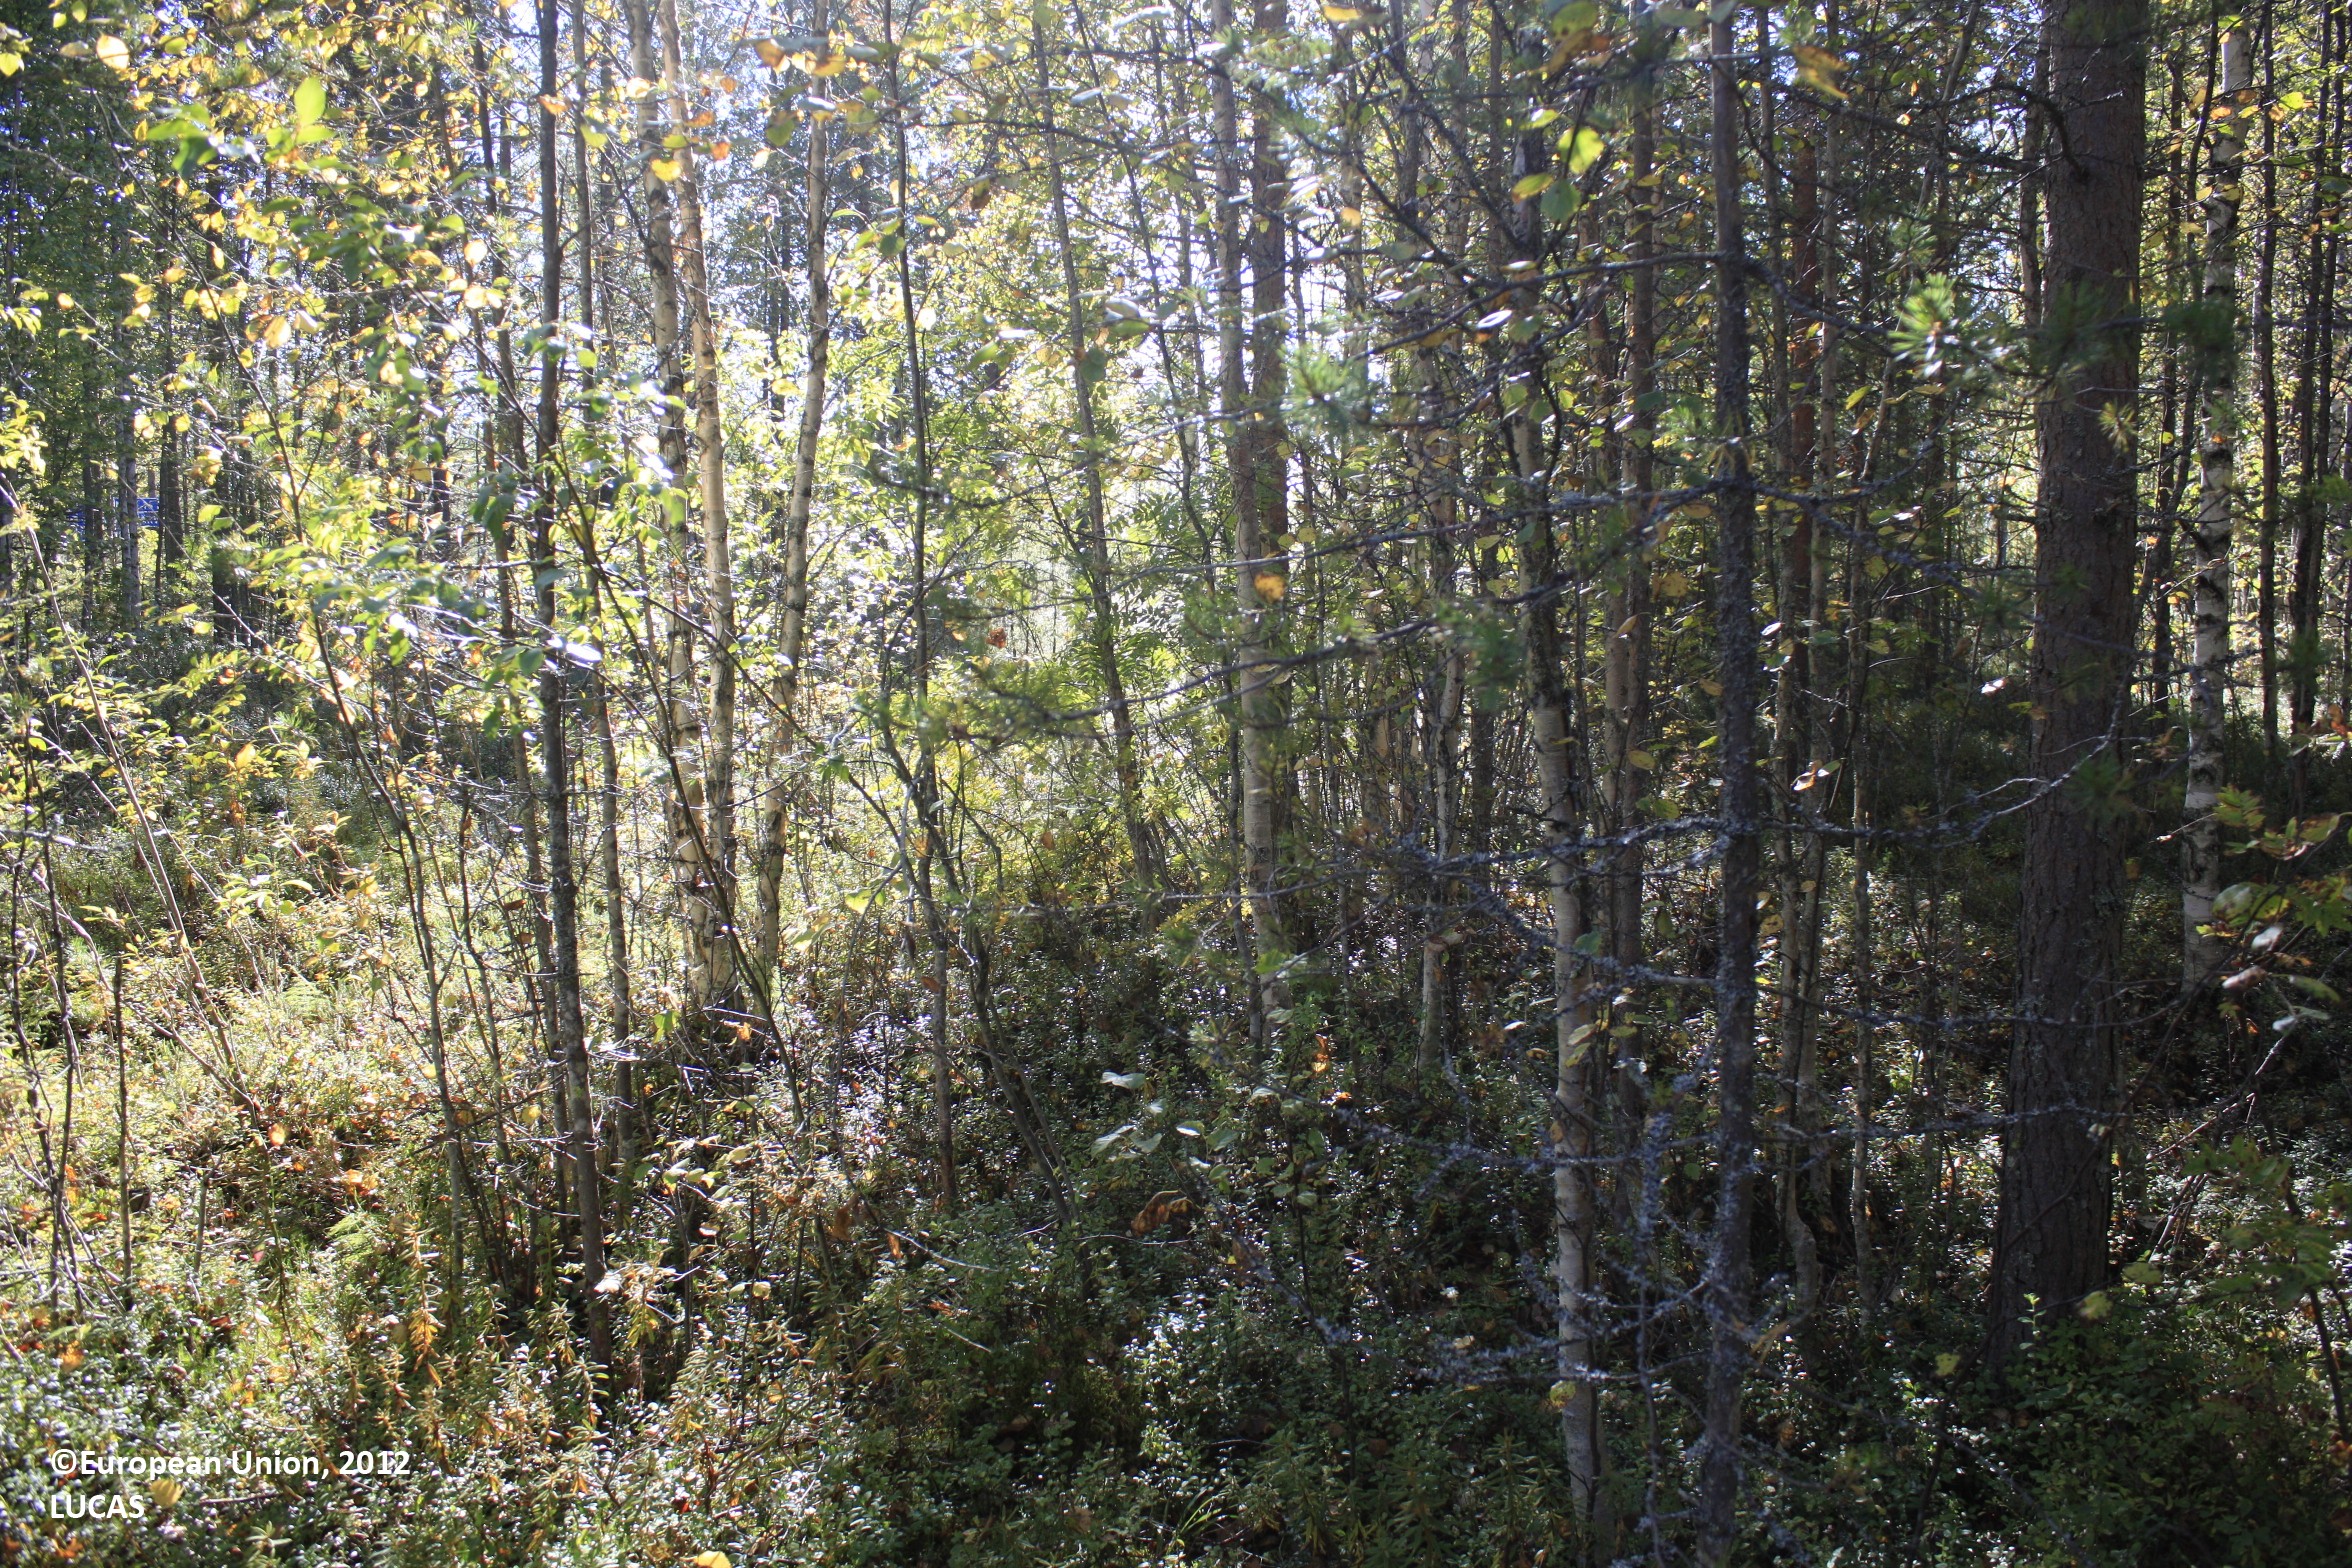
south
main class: Woodland
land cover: Pine dominated mixed woodland
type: boreal forest
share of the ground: 25 - 50 %
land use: Forestry
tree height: > 5 m
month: September
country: FI
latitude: 65.0660
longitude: 27.0224
